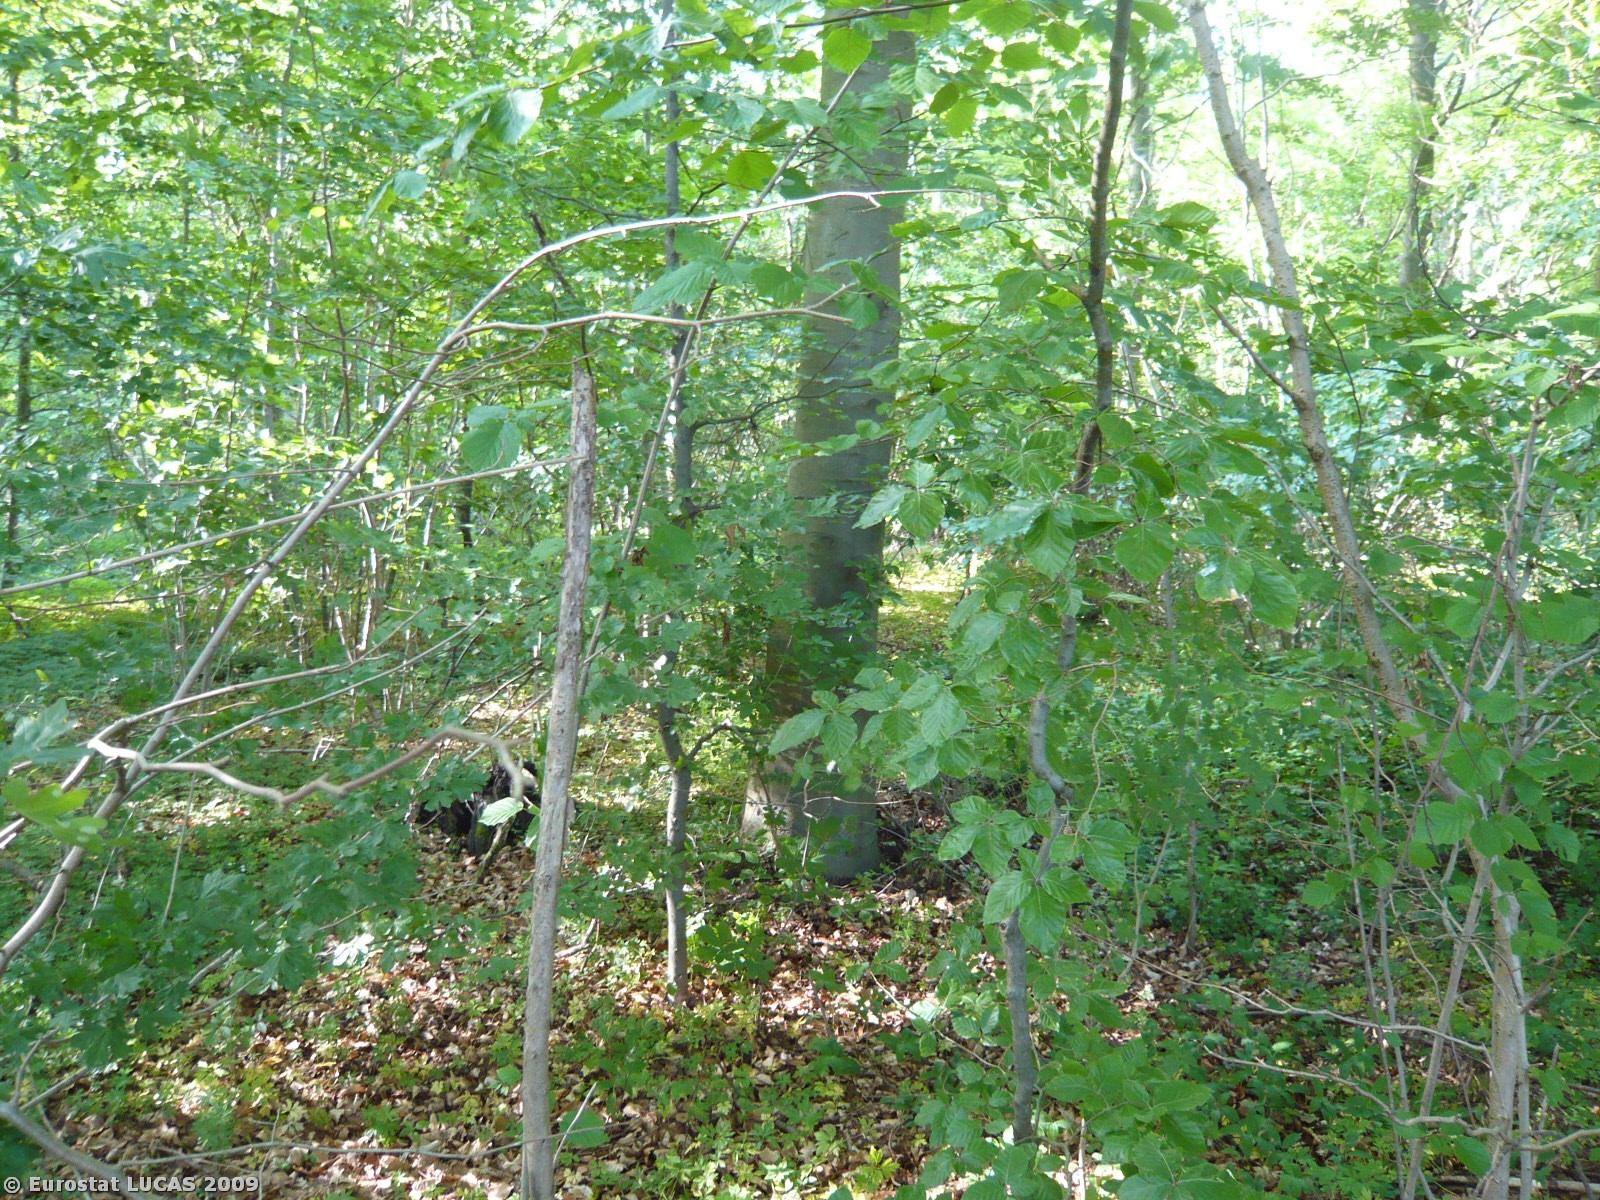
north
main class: Woodland
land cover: Broadleaved woodland
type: mesophytic deciduous forest
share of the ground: > 75 %
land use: Amenities, museums, leisure
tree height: > 5 m
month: June
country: DK
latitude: 54.8785
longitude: 11.9470
